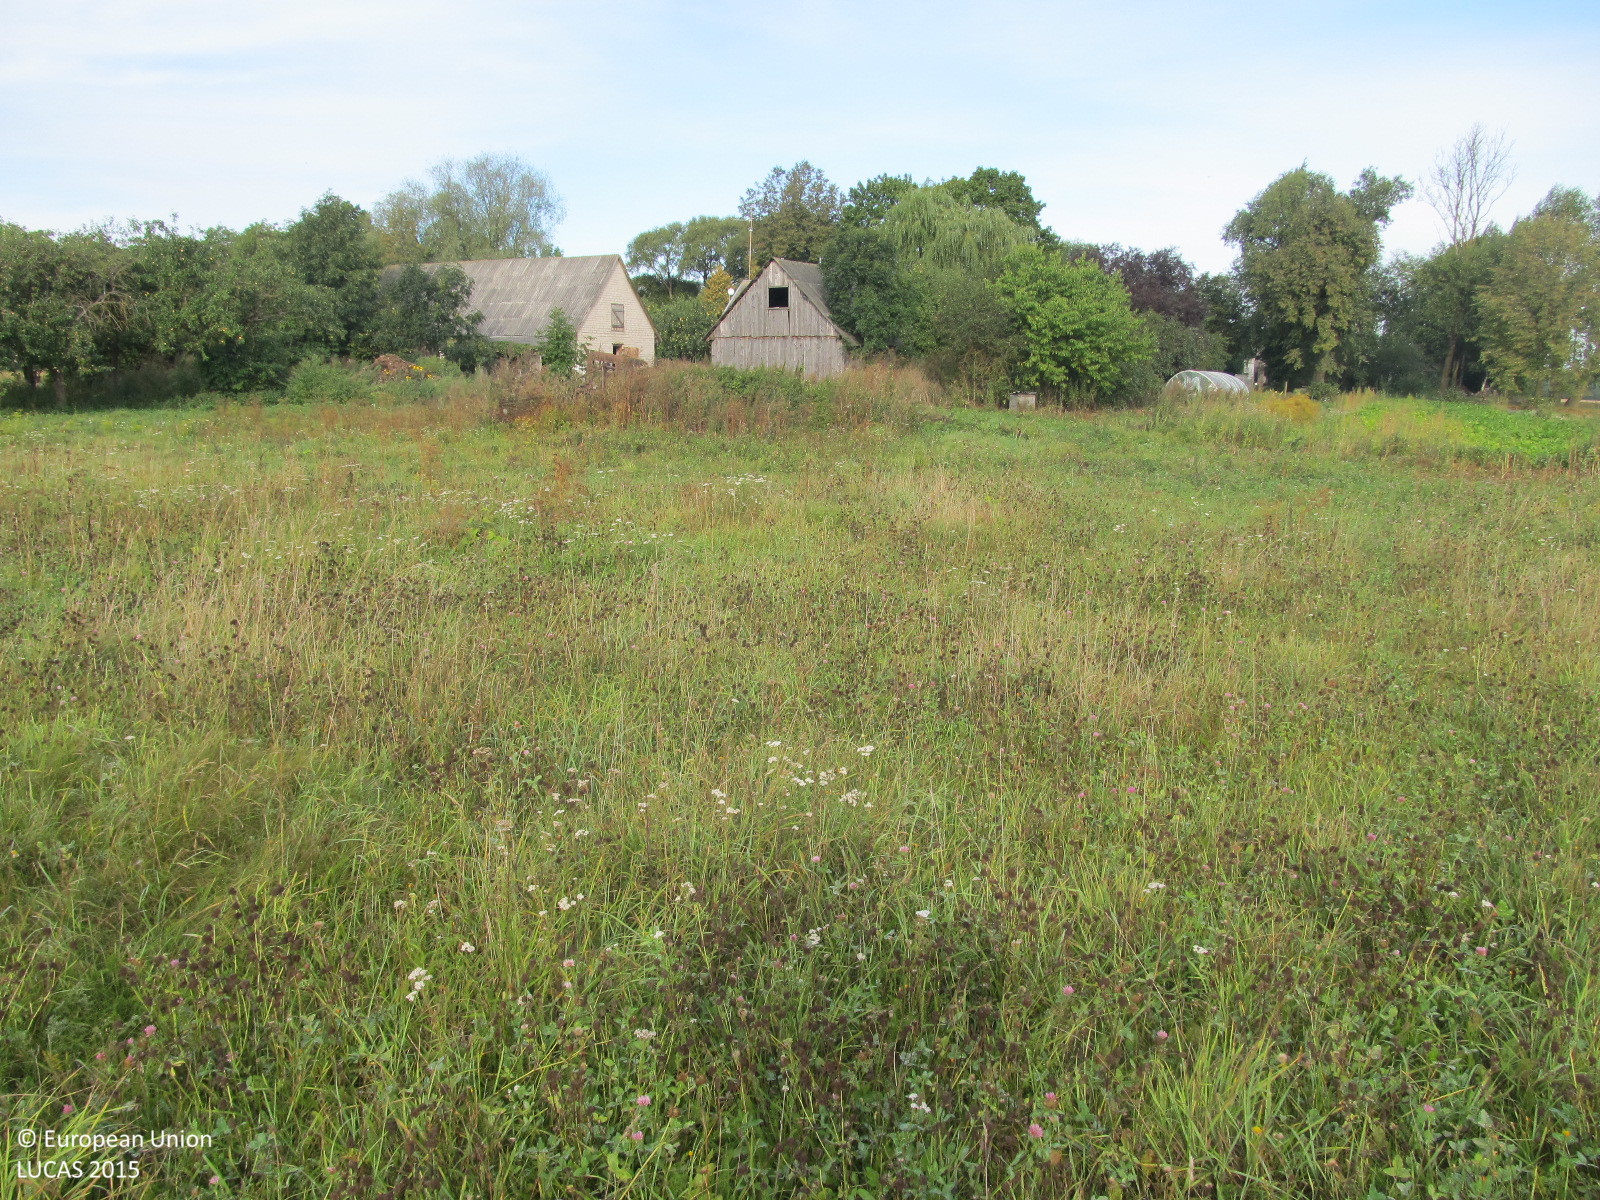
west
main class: Grassland
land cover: Grassland without tree/shrub cover
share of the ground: > 75 %
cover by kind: herbaceous plants 100 %
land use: Agriculture (excluding fallow land and kitchen gardens)
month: September
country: LT
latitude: 56.3115
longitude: 23.3116
